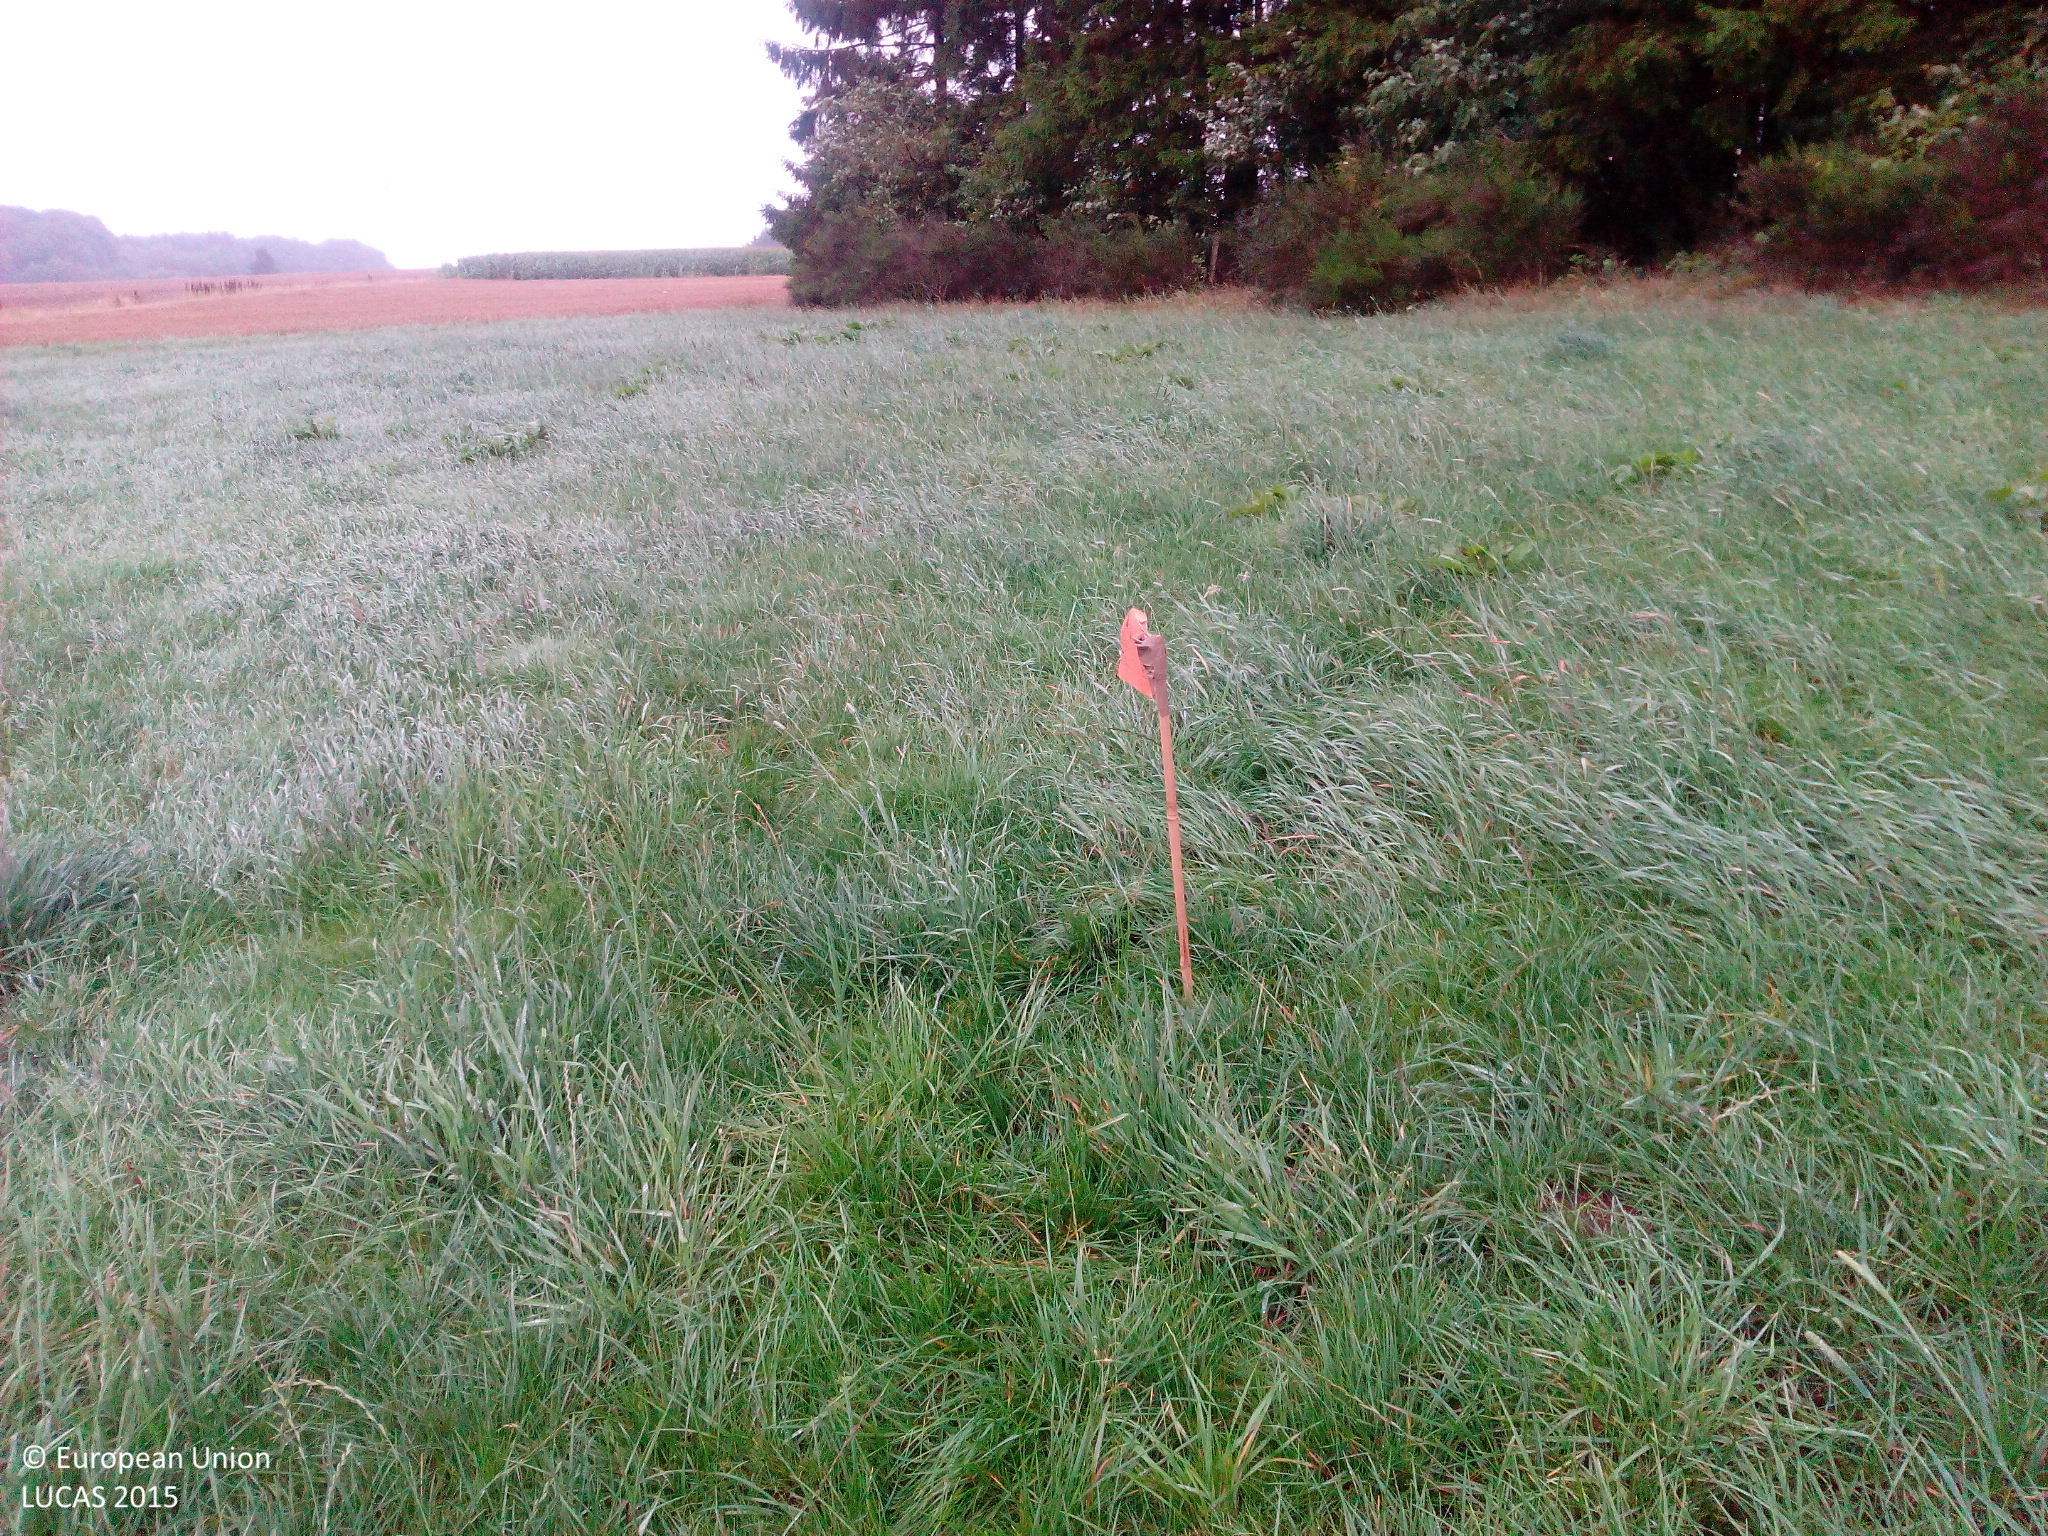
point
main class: Grassland
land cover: Grassland without tree/shrub cover
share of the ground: > 75 %
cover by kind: herbaceous plants 100 %
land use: Agriculture (excluding fallow land and kitchen gardens)
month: August
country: DE
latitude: 50.0881
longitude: 6.2956
